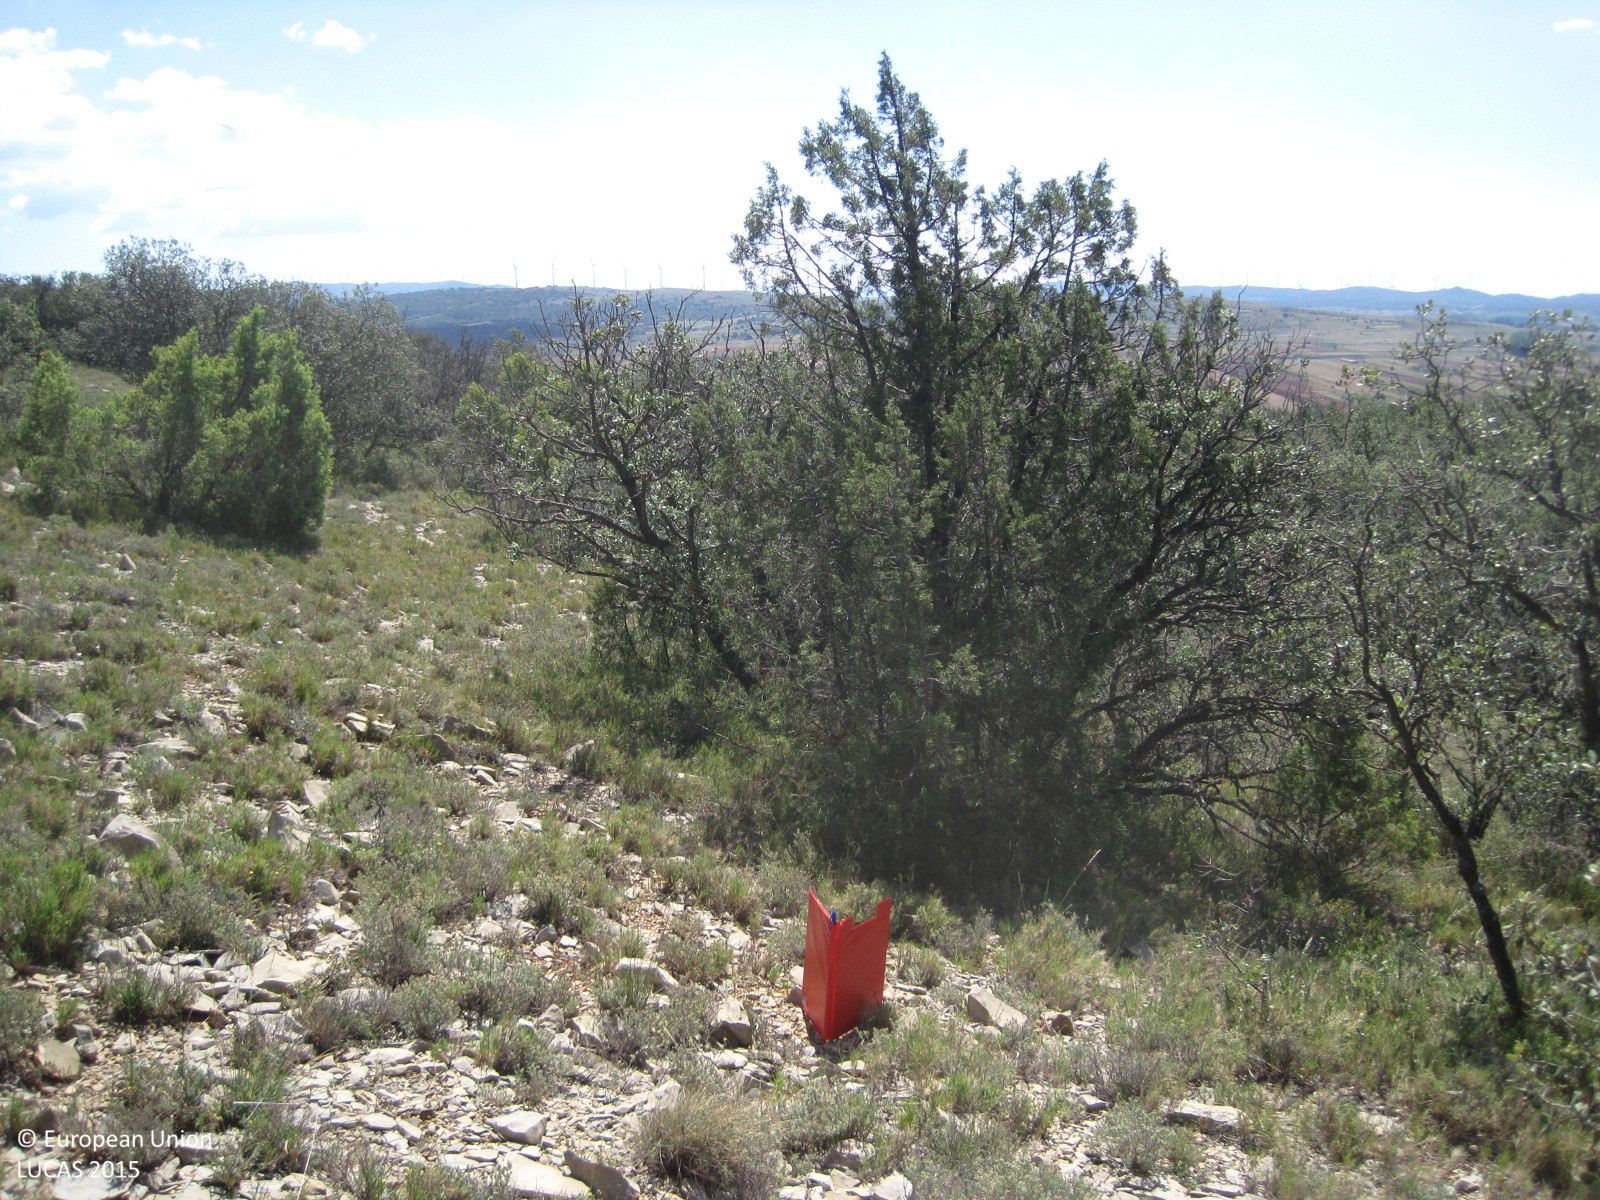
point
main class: Woodland
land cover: Broadleaved woodland
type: acidophilous oak and oak-birch forest
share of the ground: 25 - 50 %
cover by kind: herbaceous plants 35 %, broadleaved forest trees 30 %, consolidated bare surface 20 %, shrubs 10 %, coniferous forest trees 5 %
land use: Semi-natural and natural areas not in use
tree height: < 5 m
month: June
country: ES
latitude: 40.0010
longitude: -0.7695
